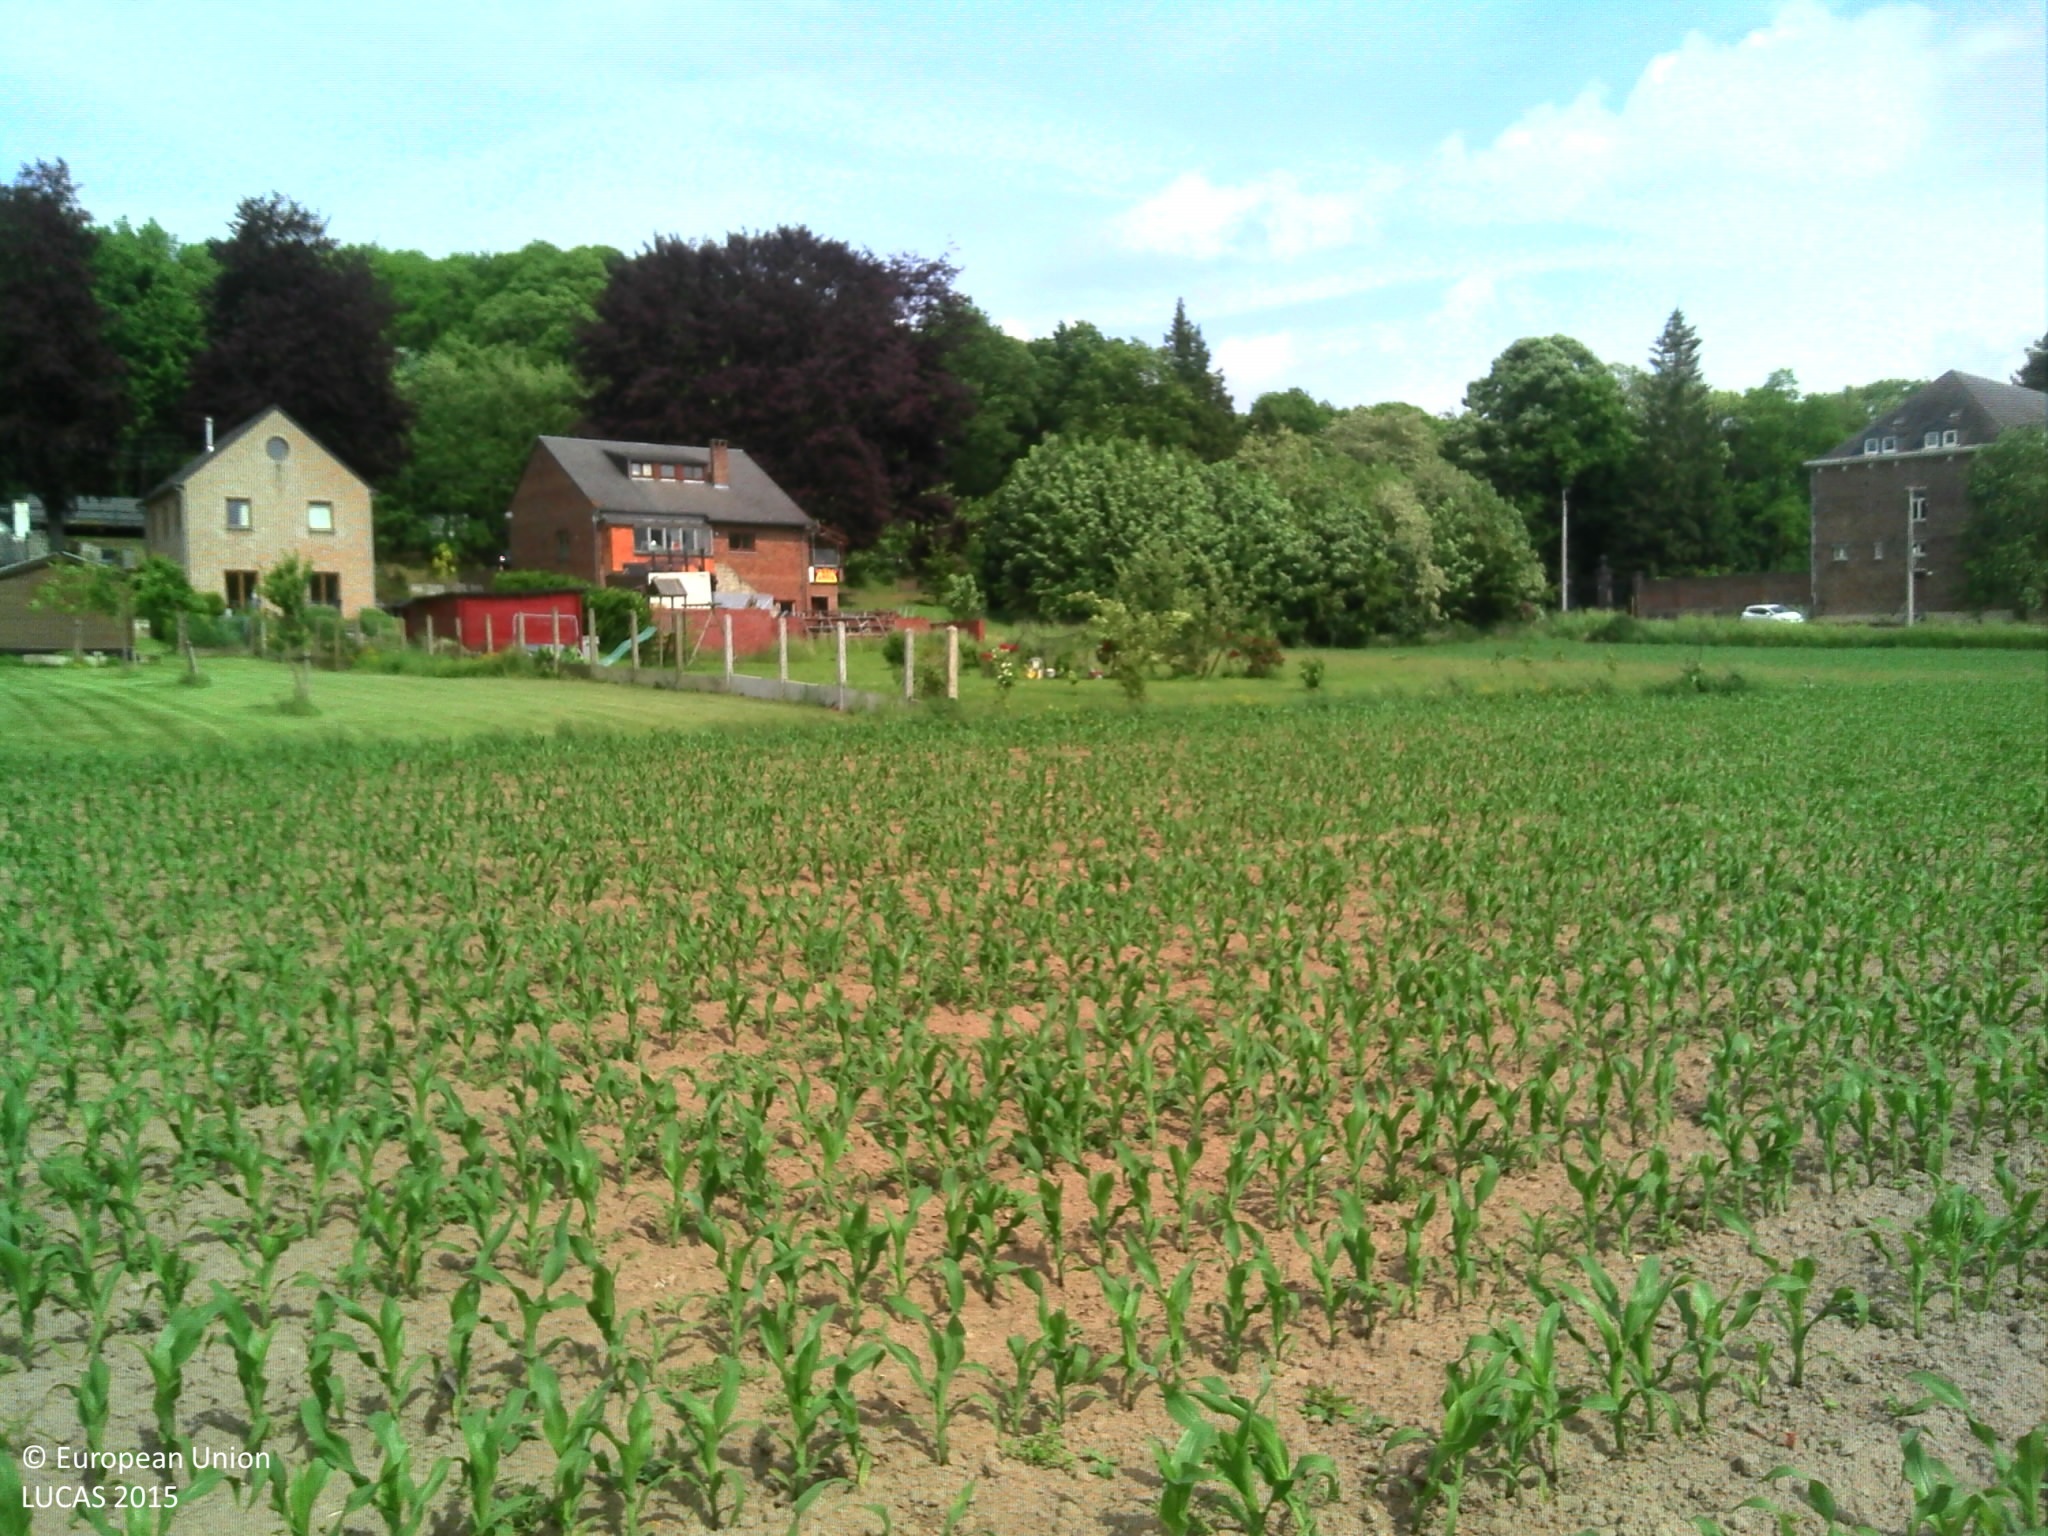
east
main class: Cropland
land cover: Maize
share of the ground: 25 - 50 %
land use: Agriculture (excluding fallow land and kitchen gardens)
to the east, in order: Maize; Grassland without tree/shrub cover; Artificial constructions in urban areas; Fences; Broadleaved woodland; Artificial constructions in urban areas; Broadleaved woodland; Electric lines; Railways; Electric lines; Broadleaved woodland
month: May
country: BE
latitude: 50.7616
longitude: 4.6515
